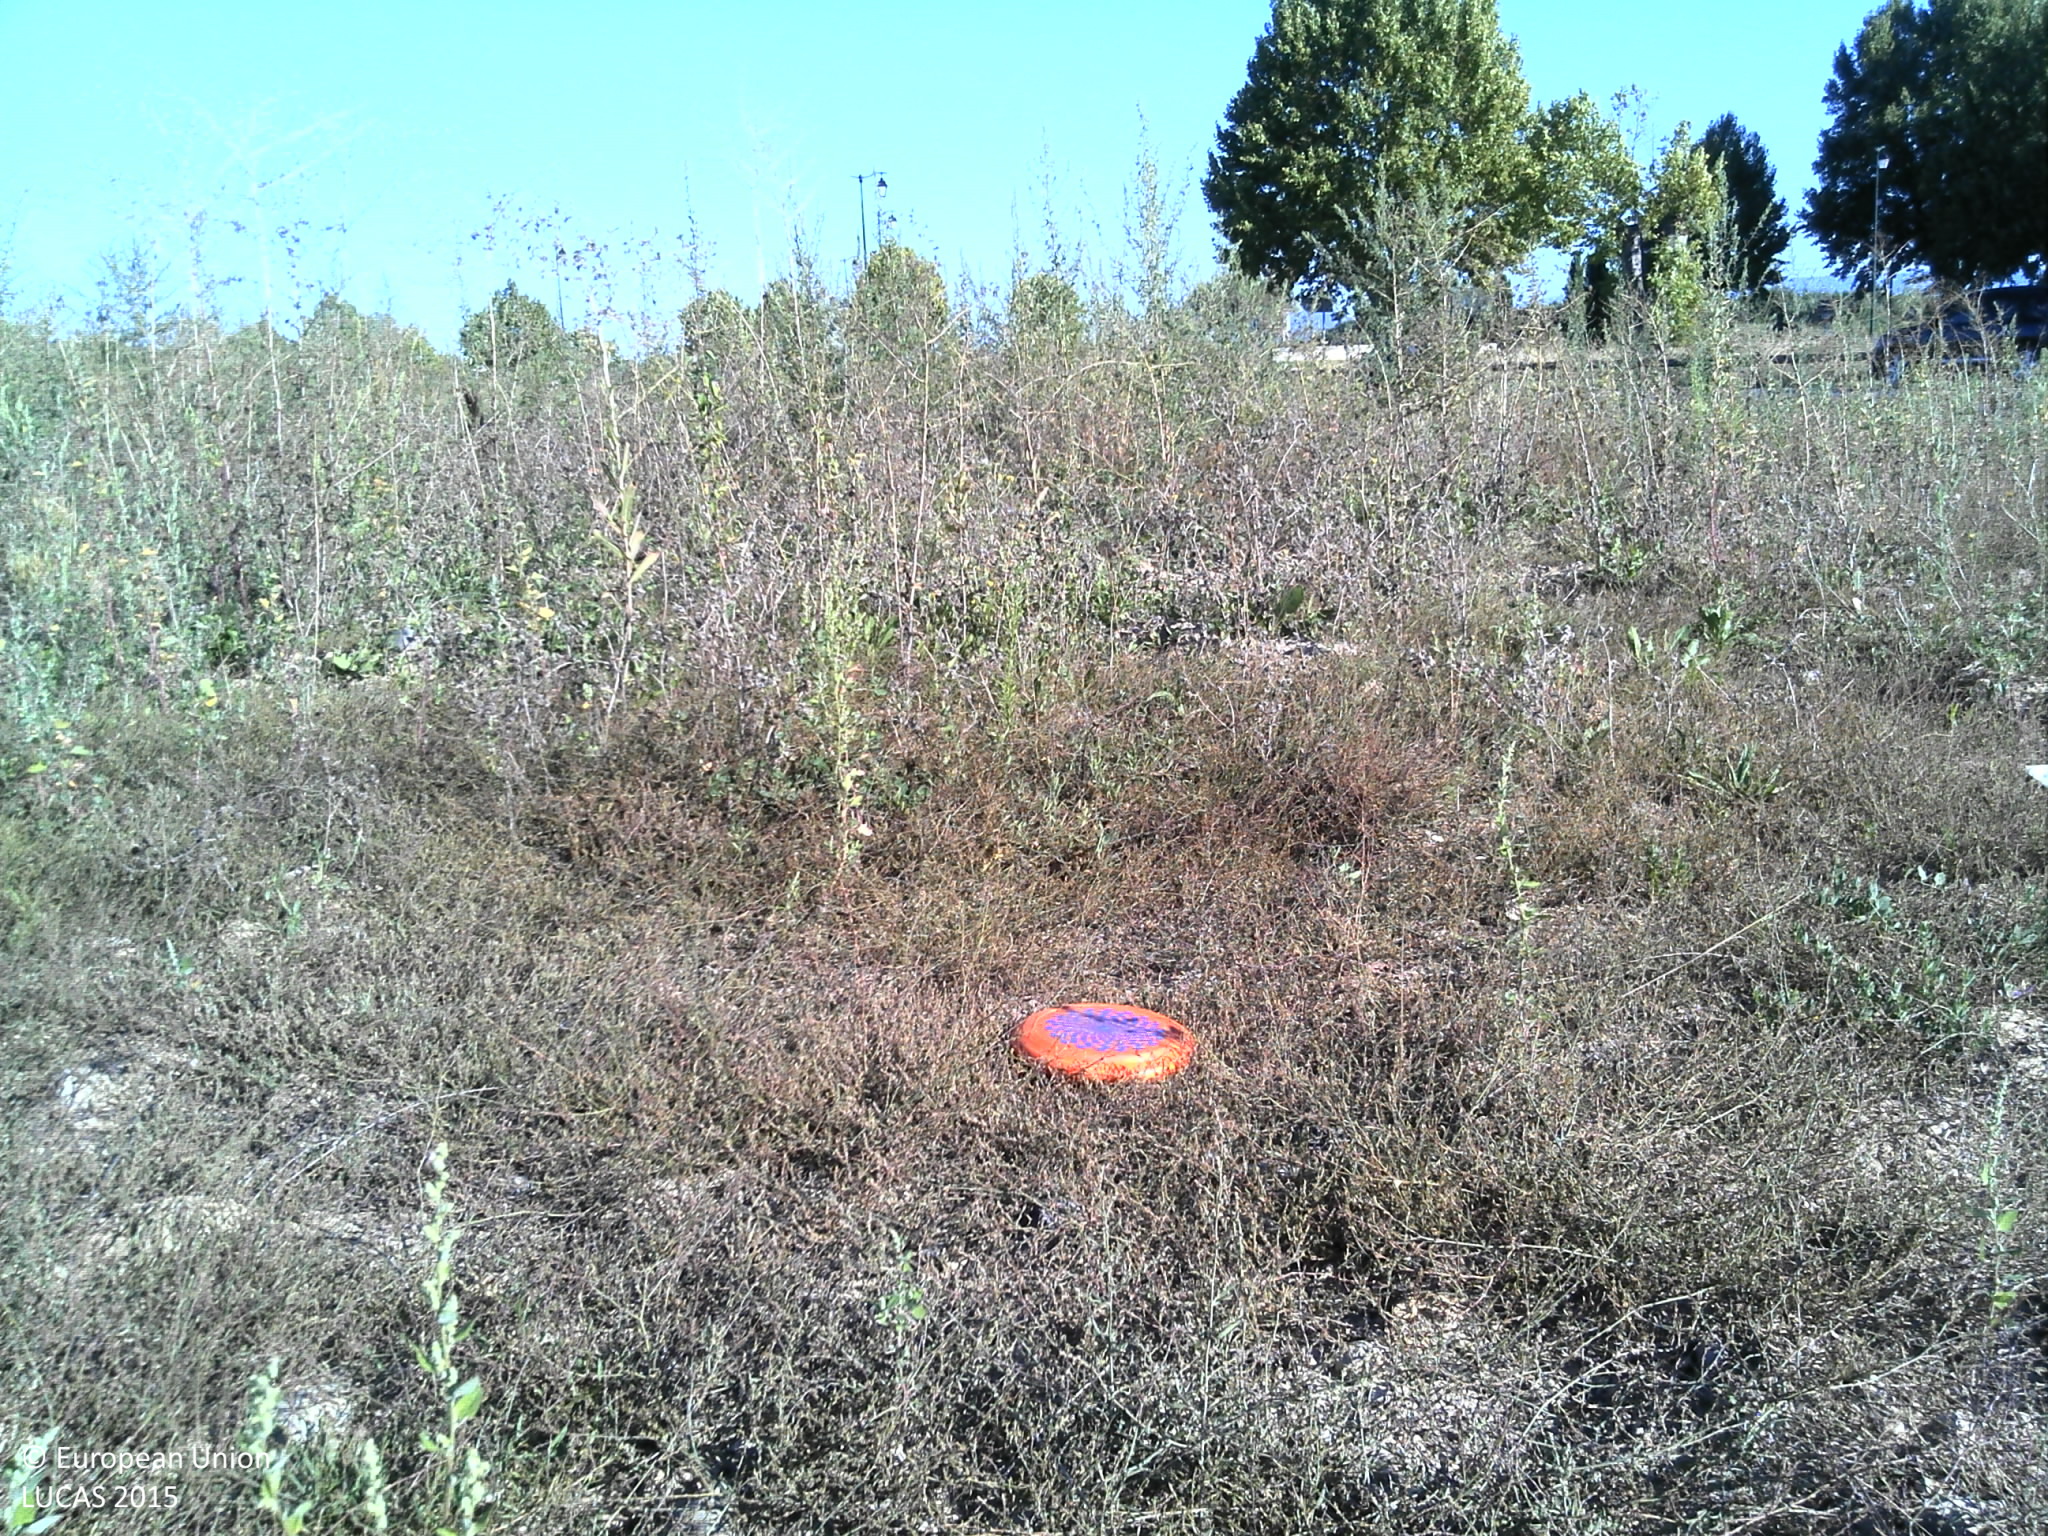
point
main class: Grassland
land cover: Spontaneously vegetated surfaces
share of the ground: > 75 %
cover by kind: herbaceous plants 70 %, unconsolidated bare surface 15 %, consolidated bare surface 10 %, shrubs 5 %
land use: Abandoned areas
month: September
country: FR
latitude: 43.7079
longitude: 5.4298
